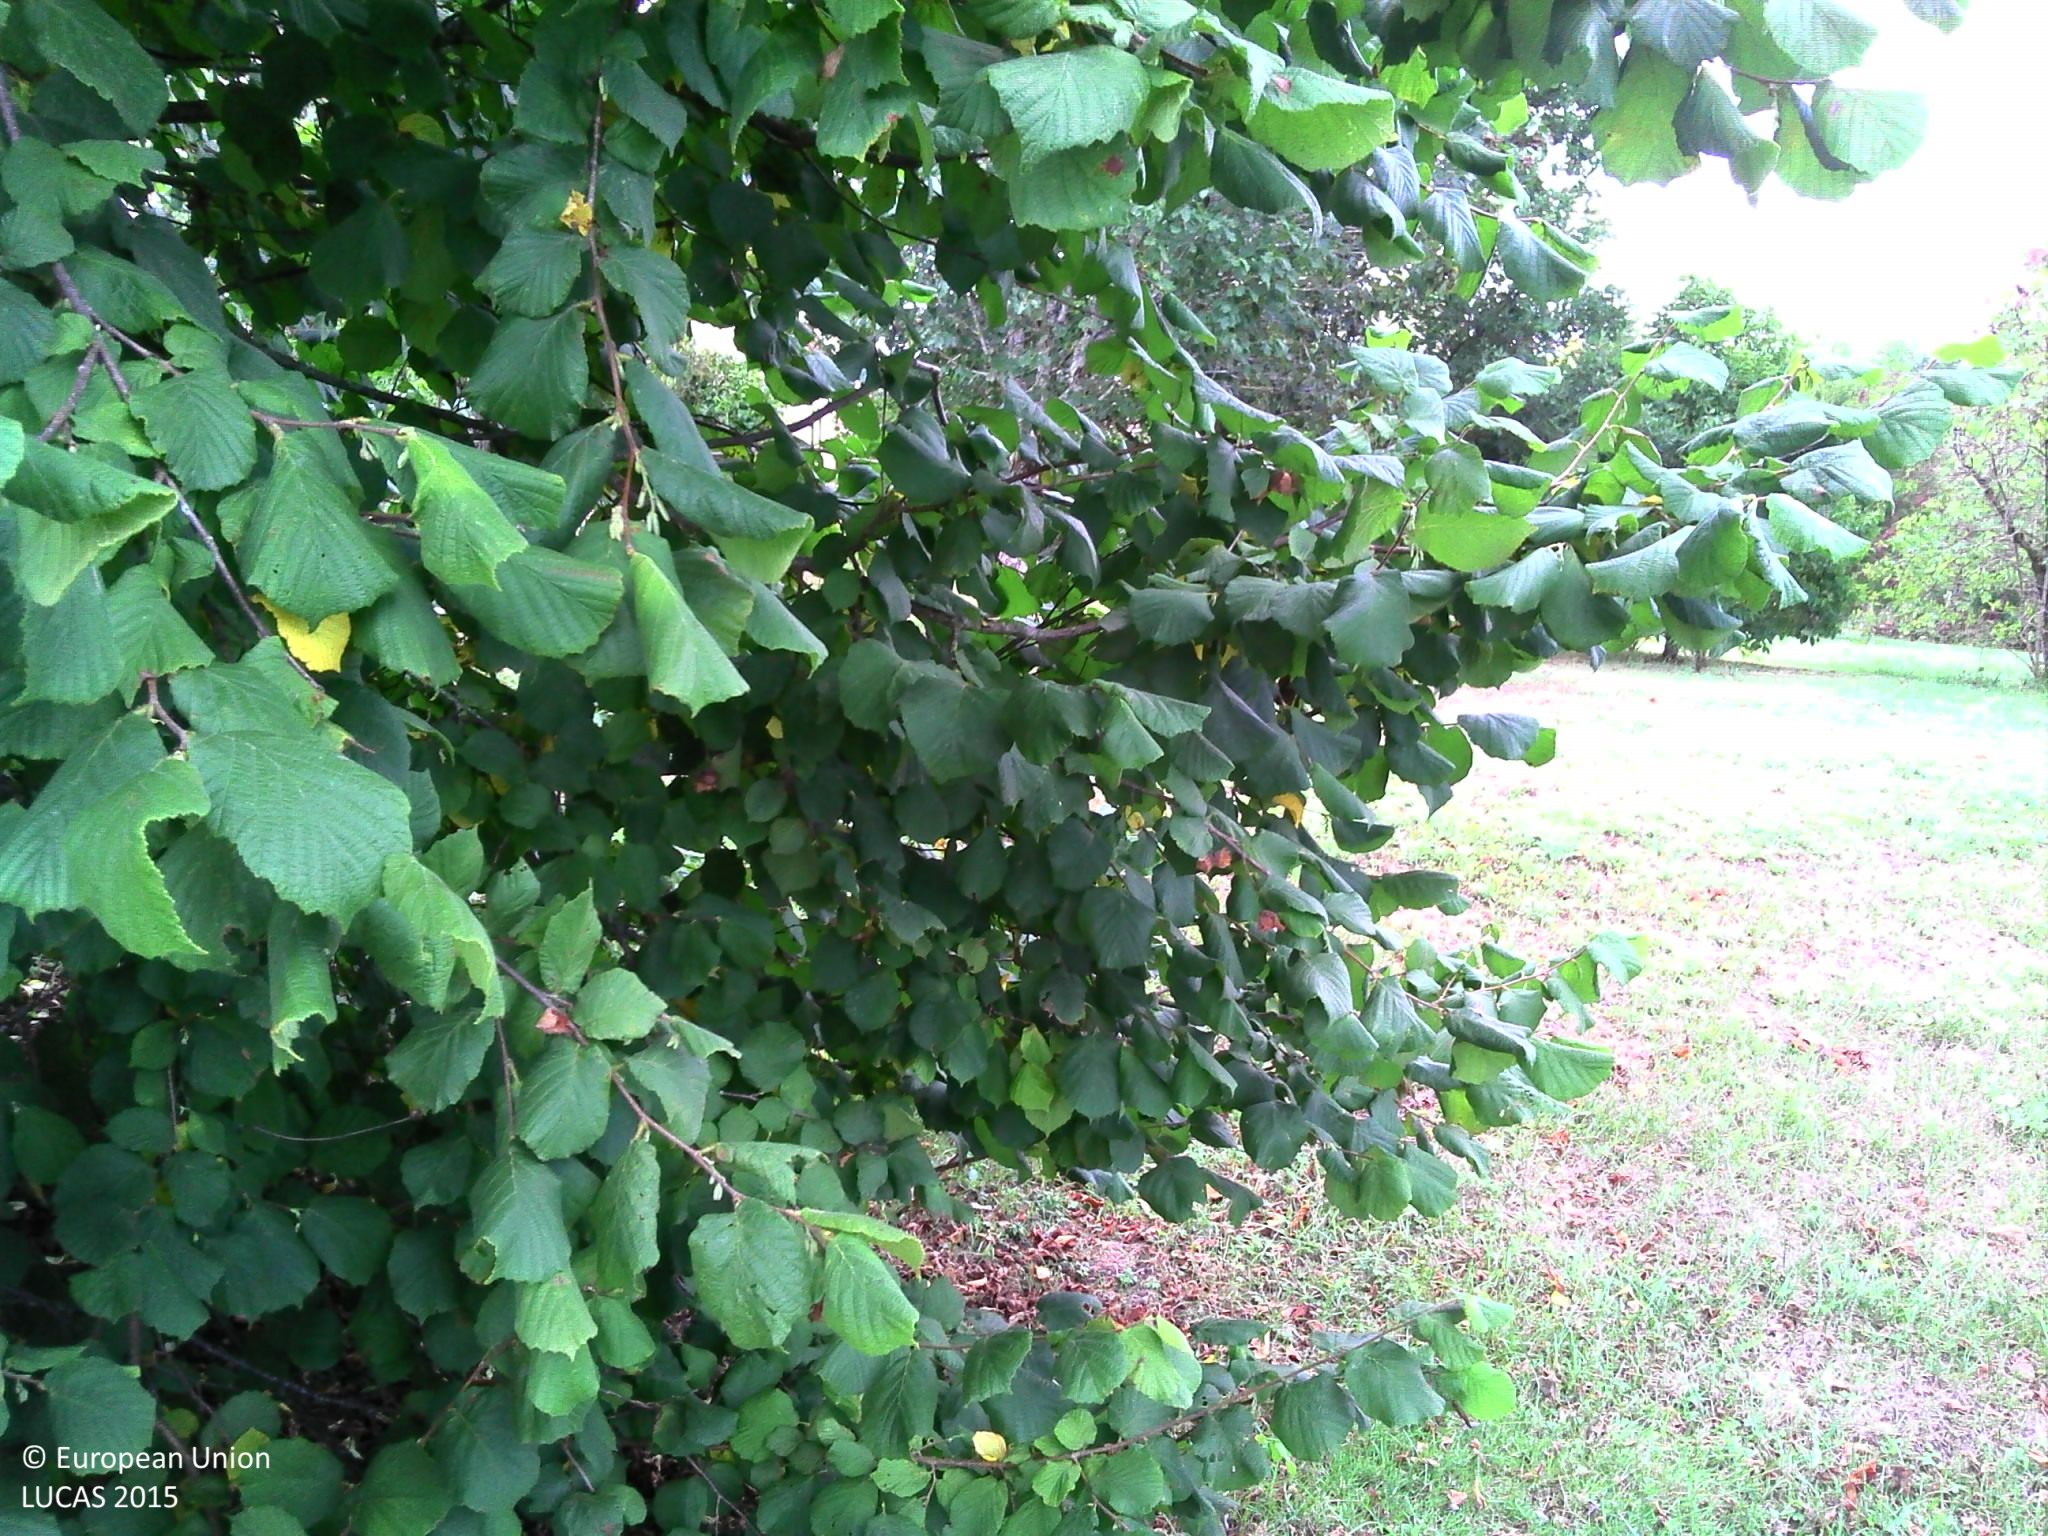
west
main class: Grassland
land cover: Grassland with sparse tree/shrub cover
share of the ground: > 75 %
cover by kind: herbaceous plants 95 %, broadleaved forest trees 5 %
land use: Residential
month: August
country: FR
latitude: 43.9682
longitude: 1.5379
